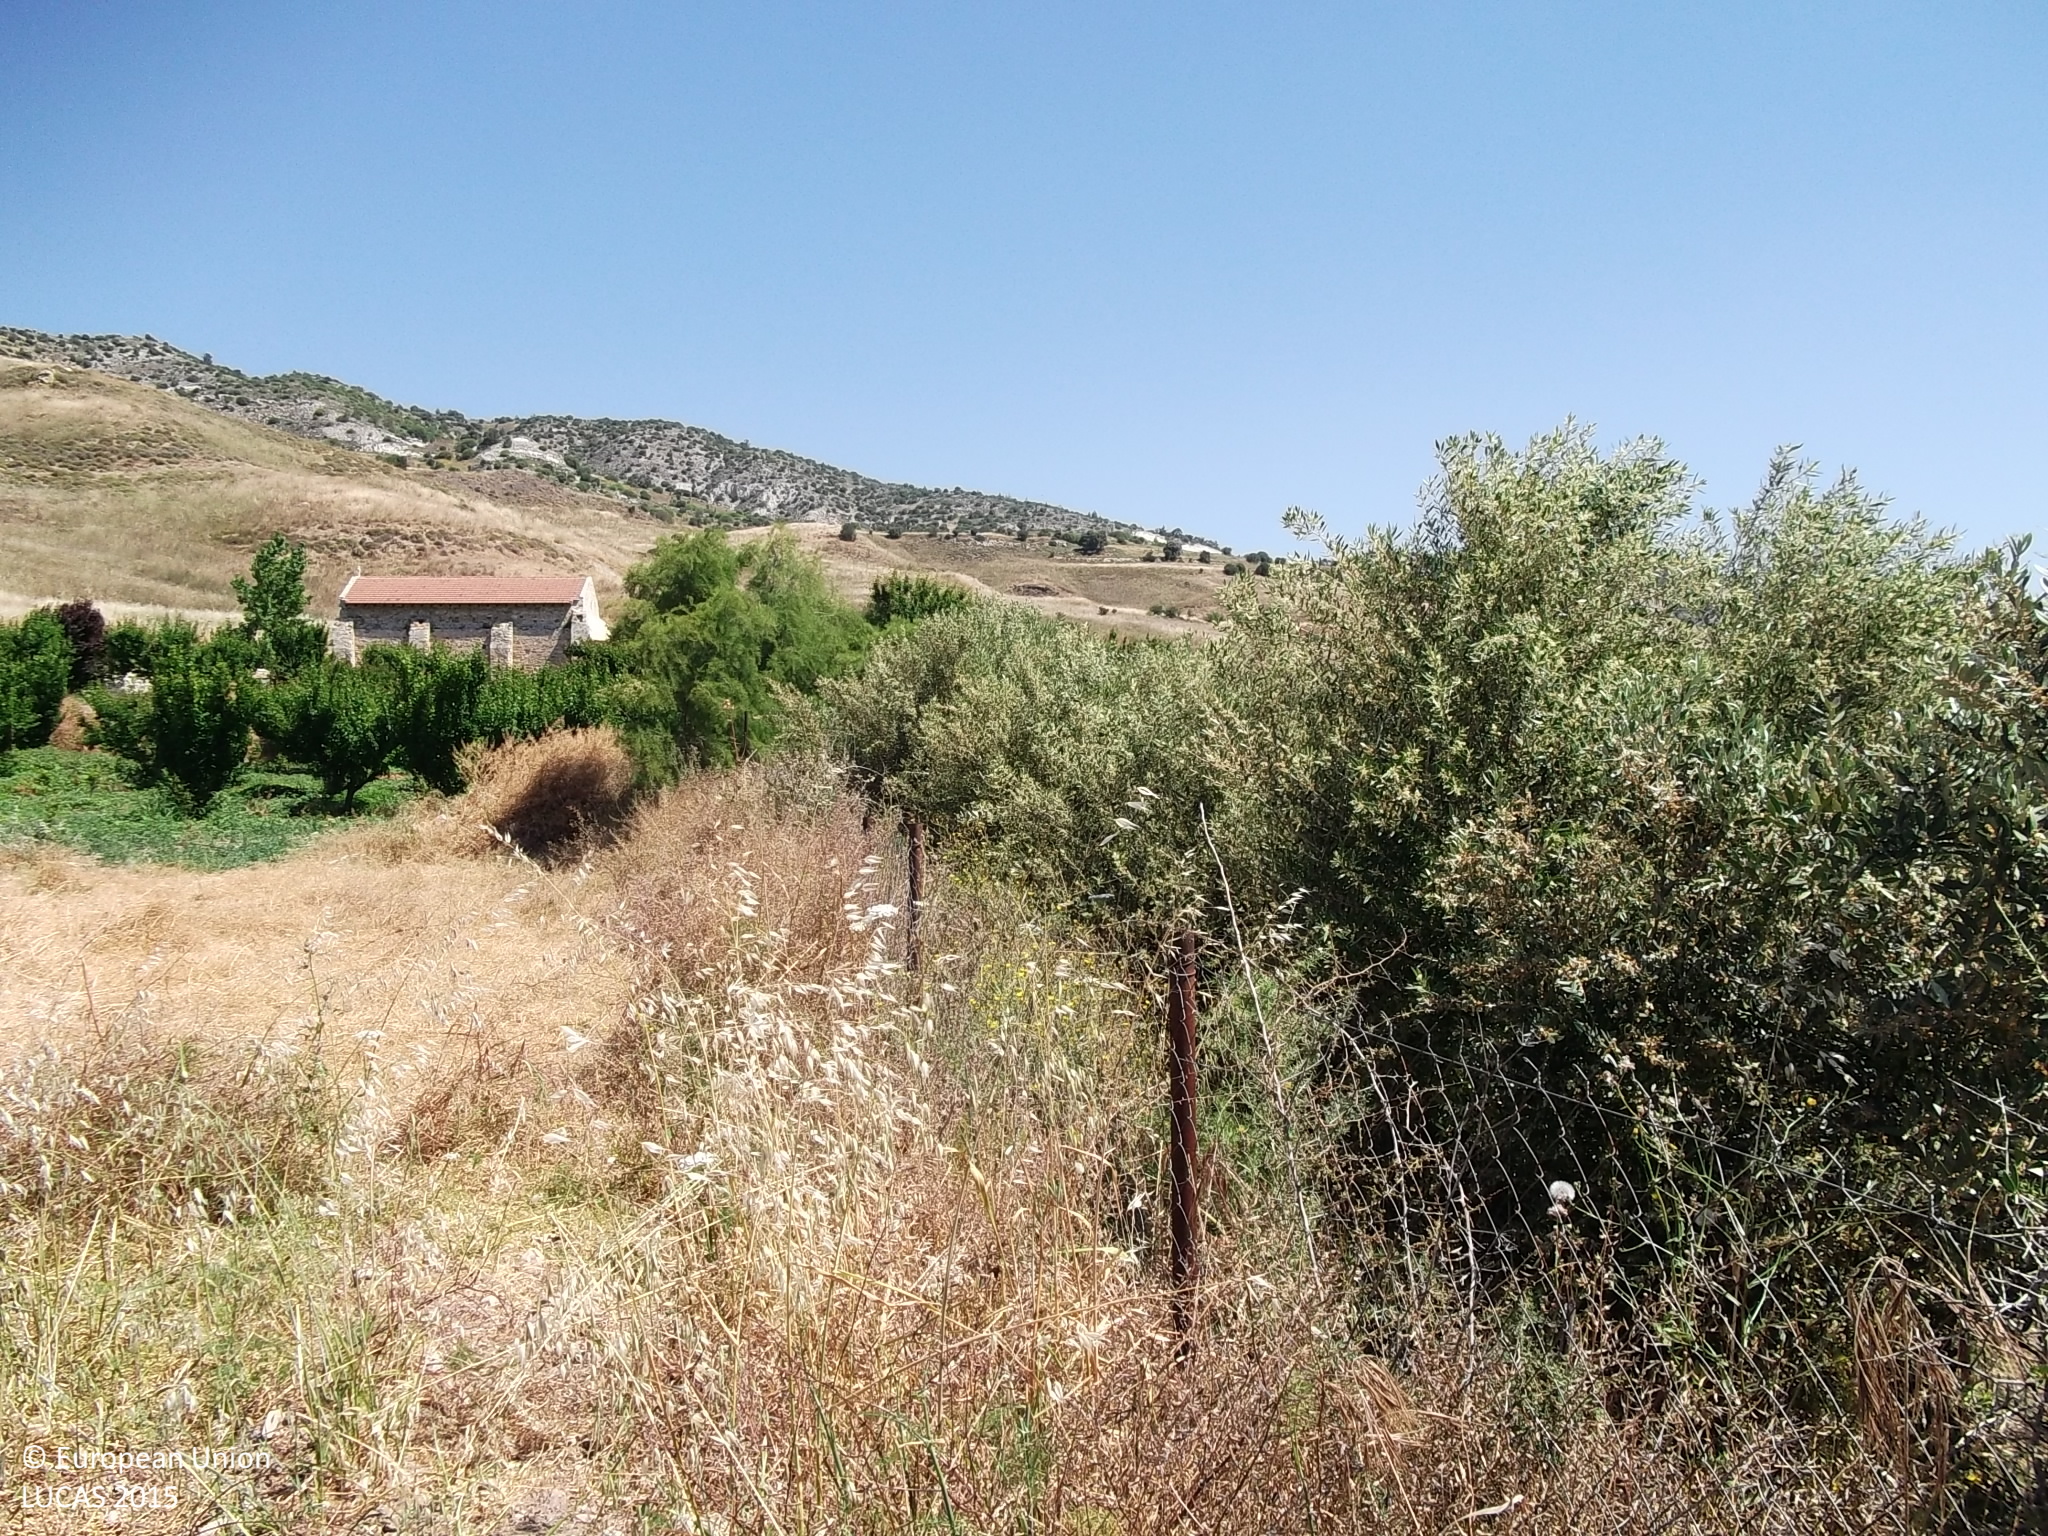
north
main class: Cropland
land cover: Oranges
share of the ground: > 75 %
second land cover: Olive groves
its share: 10 - 25 %
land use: Agriculture (excluding fallow land and kitchen gardens)
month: May
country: CY
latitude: 34.7861
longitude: 32.5871
